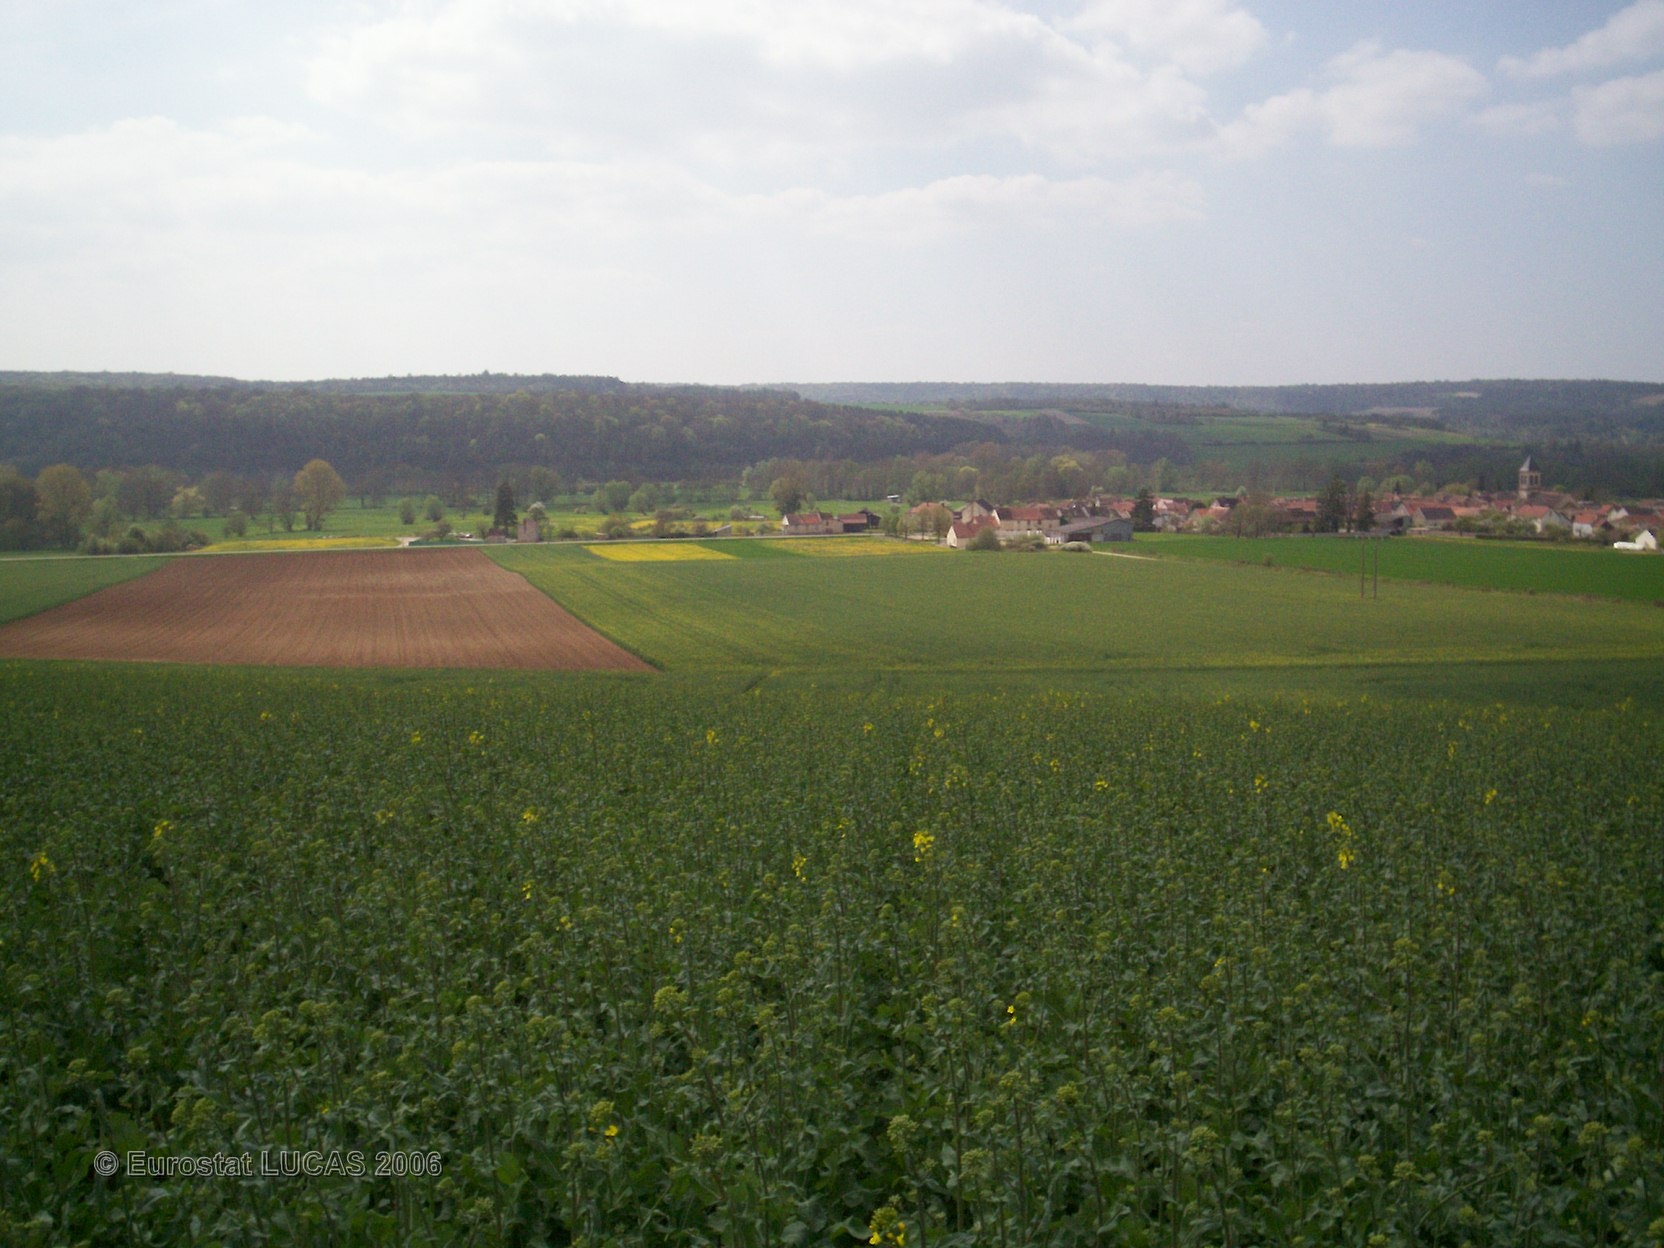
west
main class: Cropland
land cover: Rape and turnip rape
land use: Agriculture (excluding fallow land and kitchen gardens)
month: April
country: FR
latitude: 47.9431
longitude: 4.5226
